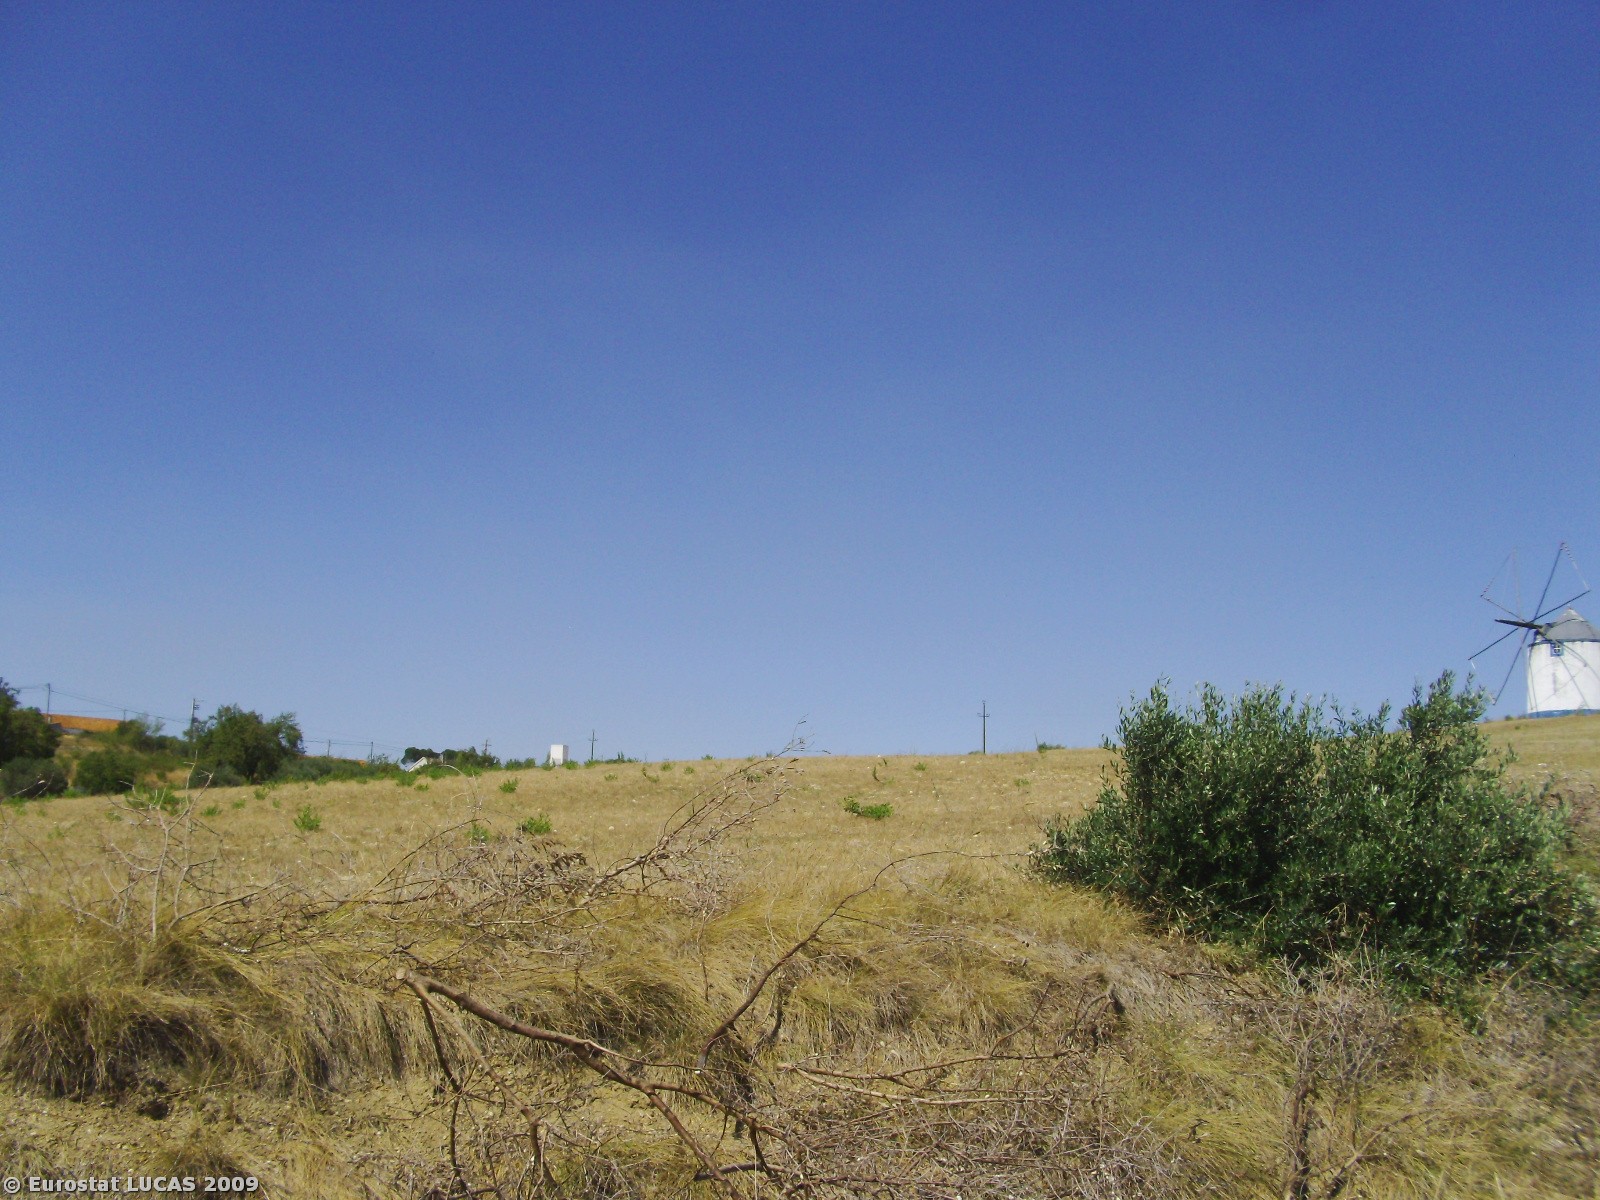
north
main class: Grassland
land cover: Grassland without tree/shrub cover
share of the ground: > 75 %
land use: Agriculture (excluding fallow land and kitchen gardens)
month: July
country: PT
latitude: 39.1779
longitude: -8.8639
